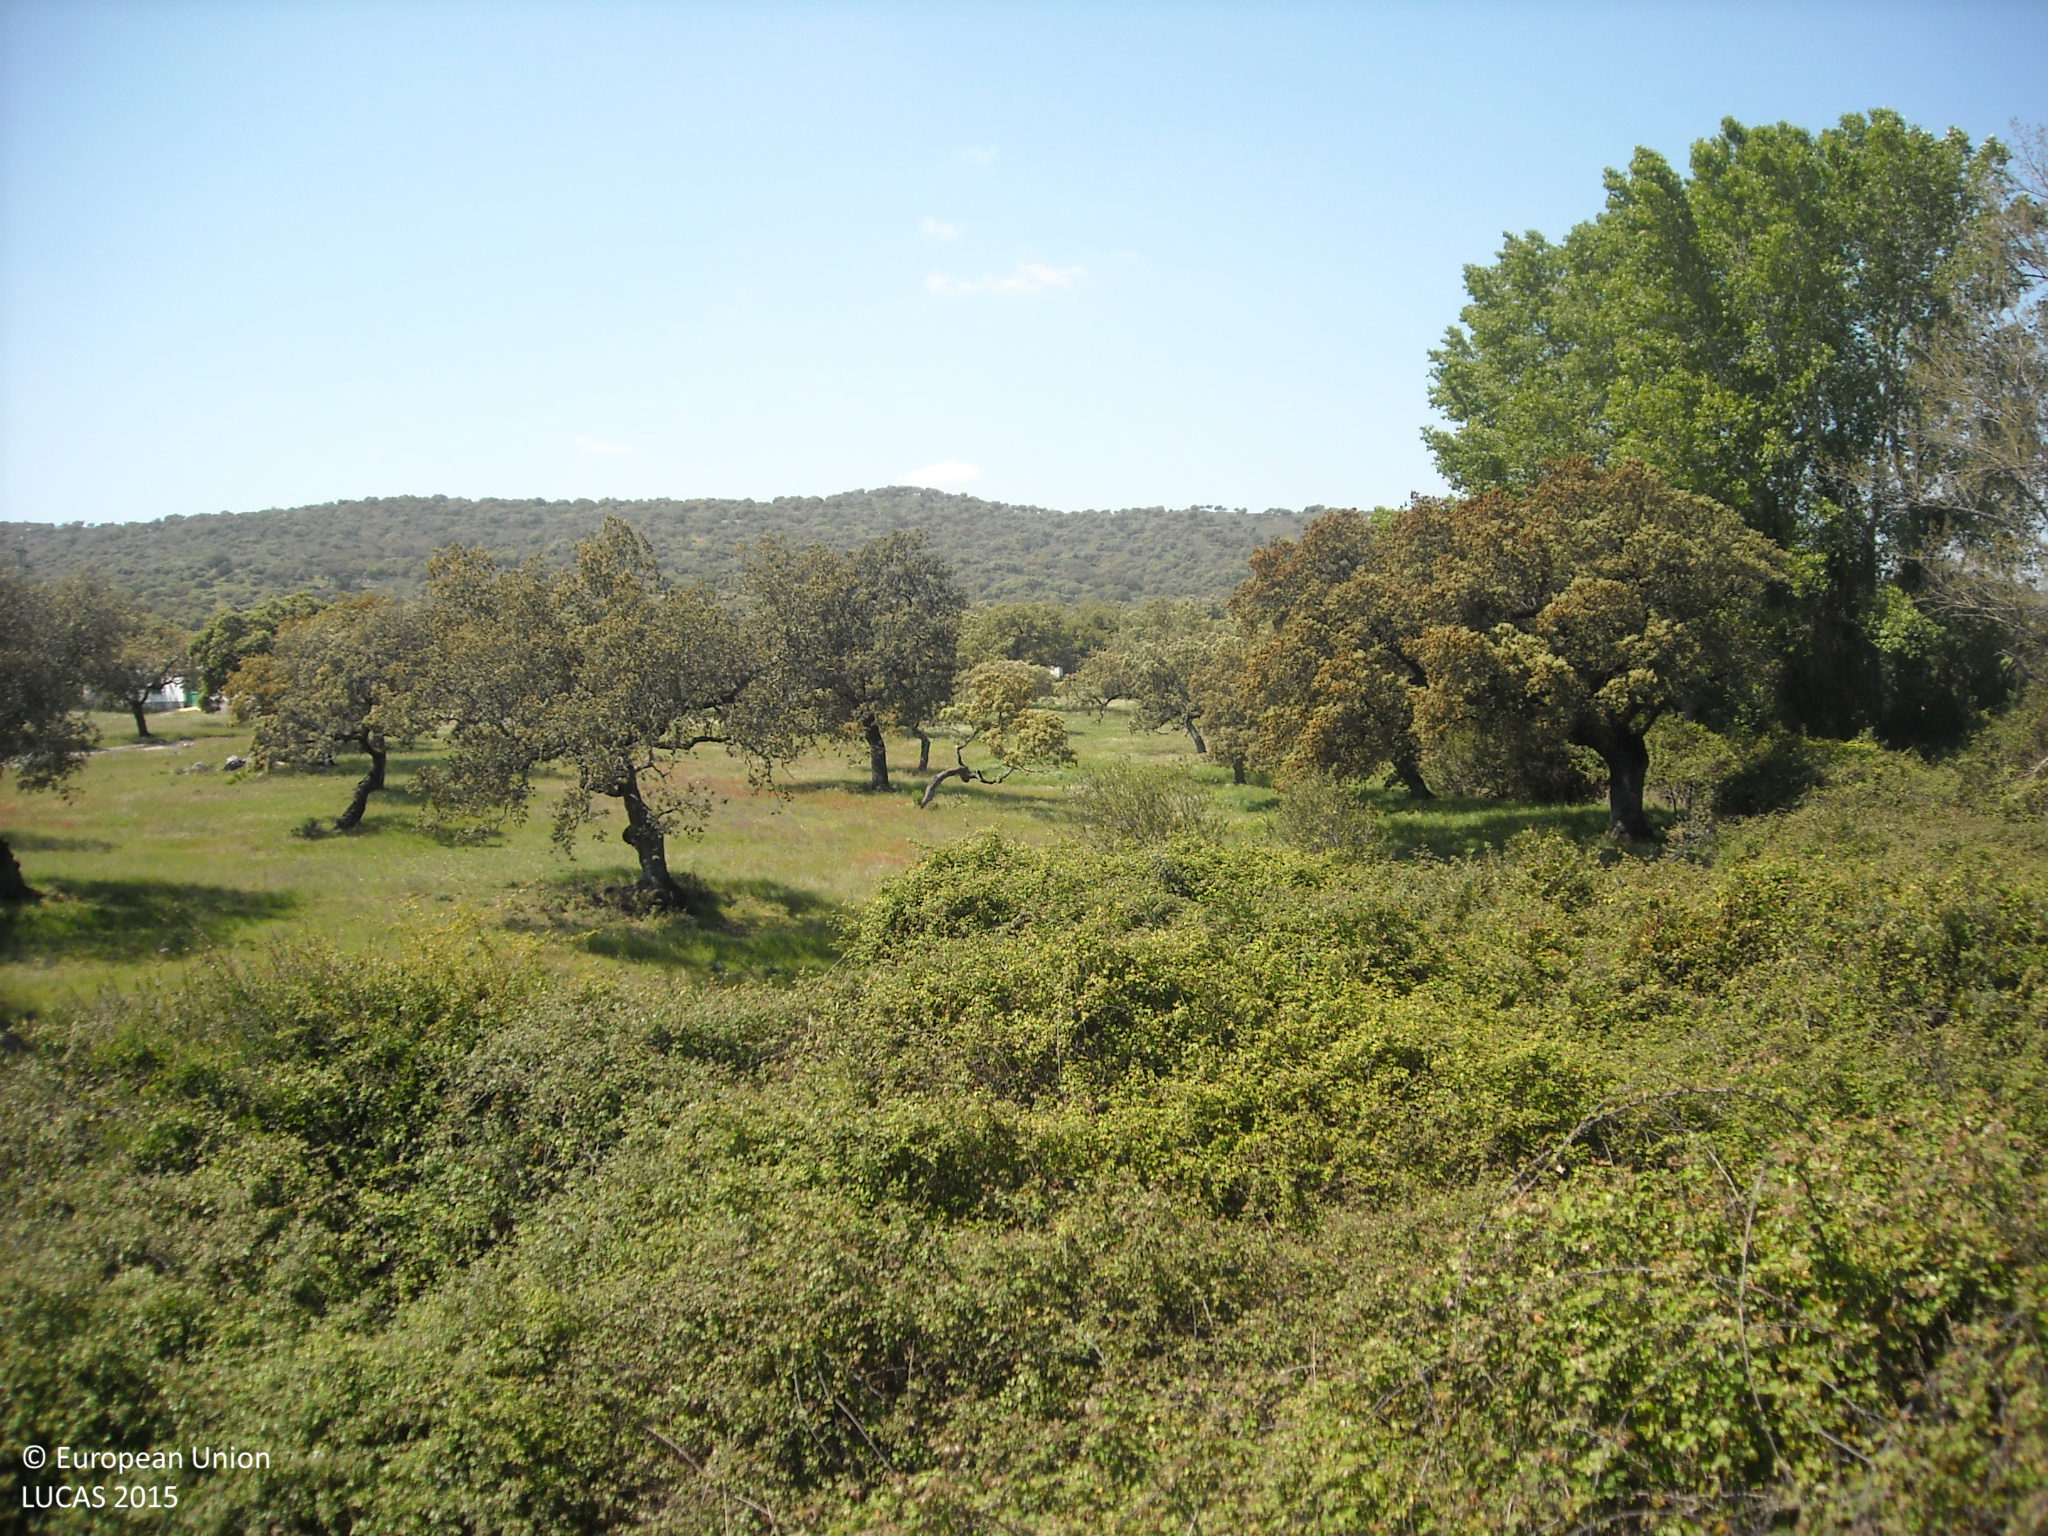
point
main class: Woodland
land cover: Broadleaved woodland
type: broadleaved evergreen forest
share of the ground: 25 - 50 %
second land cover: Grassland without tree/shrub cover
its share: > 75 %
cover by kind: herbaceous plants 75 %, broadleaved forest trees 25 %
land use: Forestry
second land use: Agriculture (excluding fallow land and kitchen gardens)
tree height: > 5 m
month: April
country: ES
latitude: 37.7695
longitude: -6.5125
